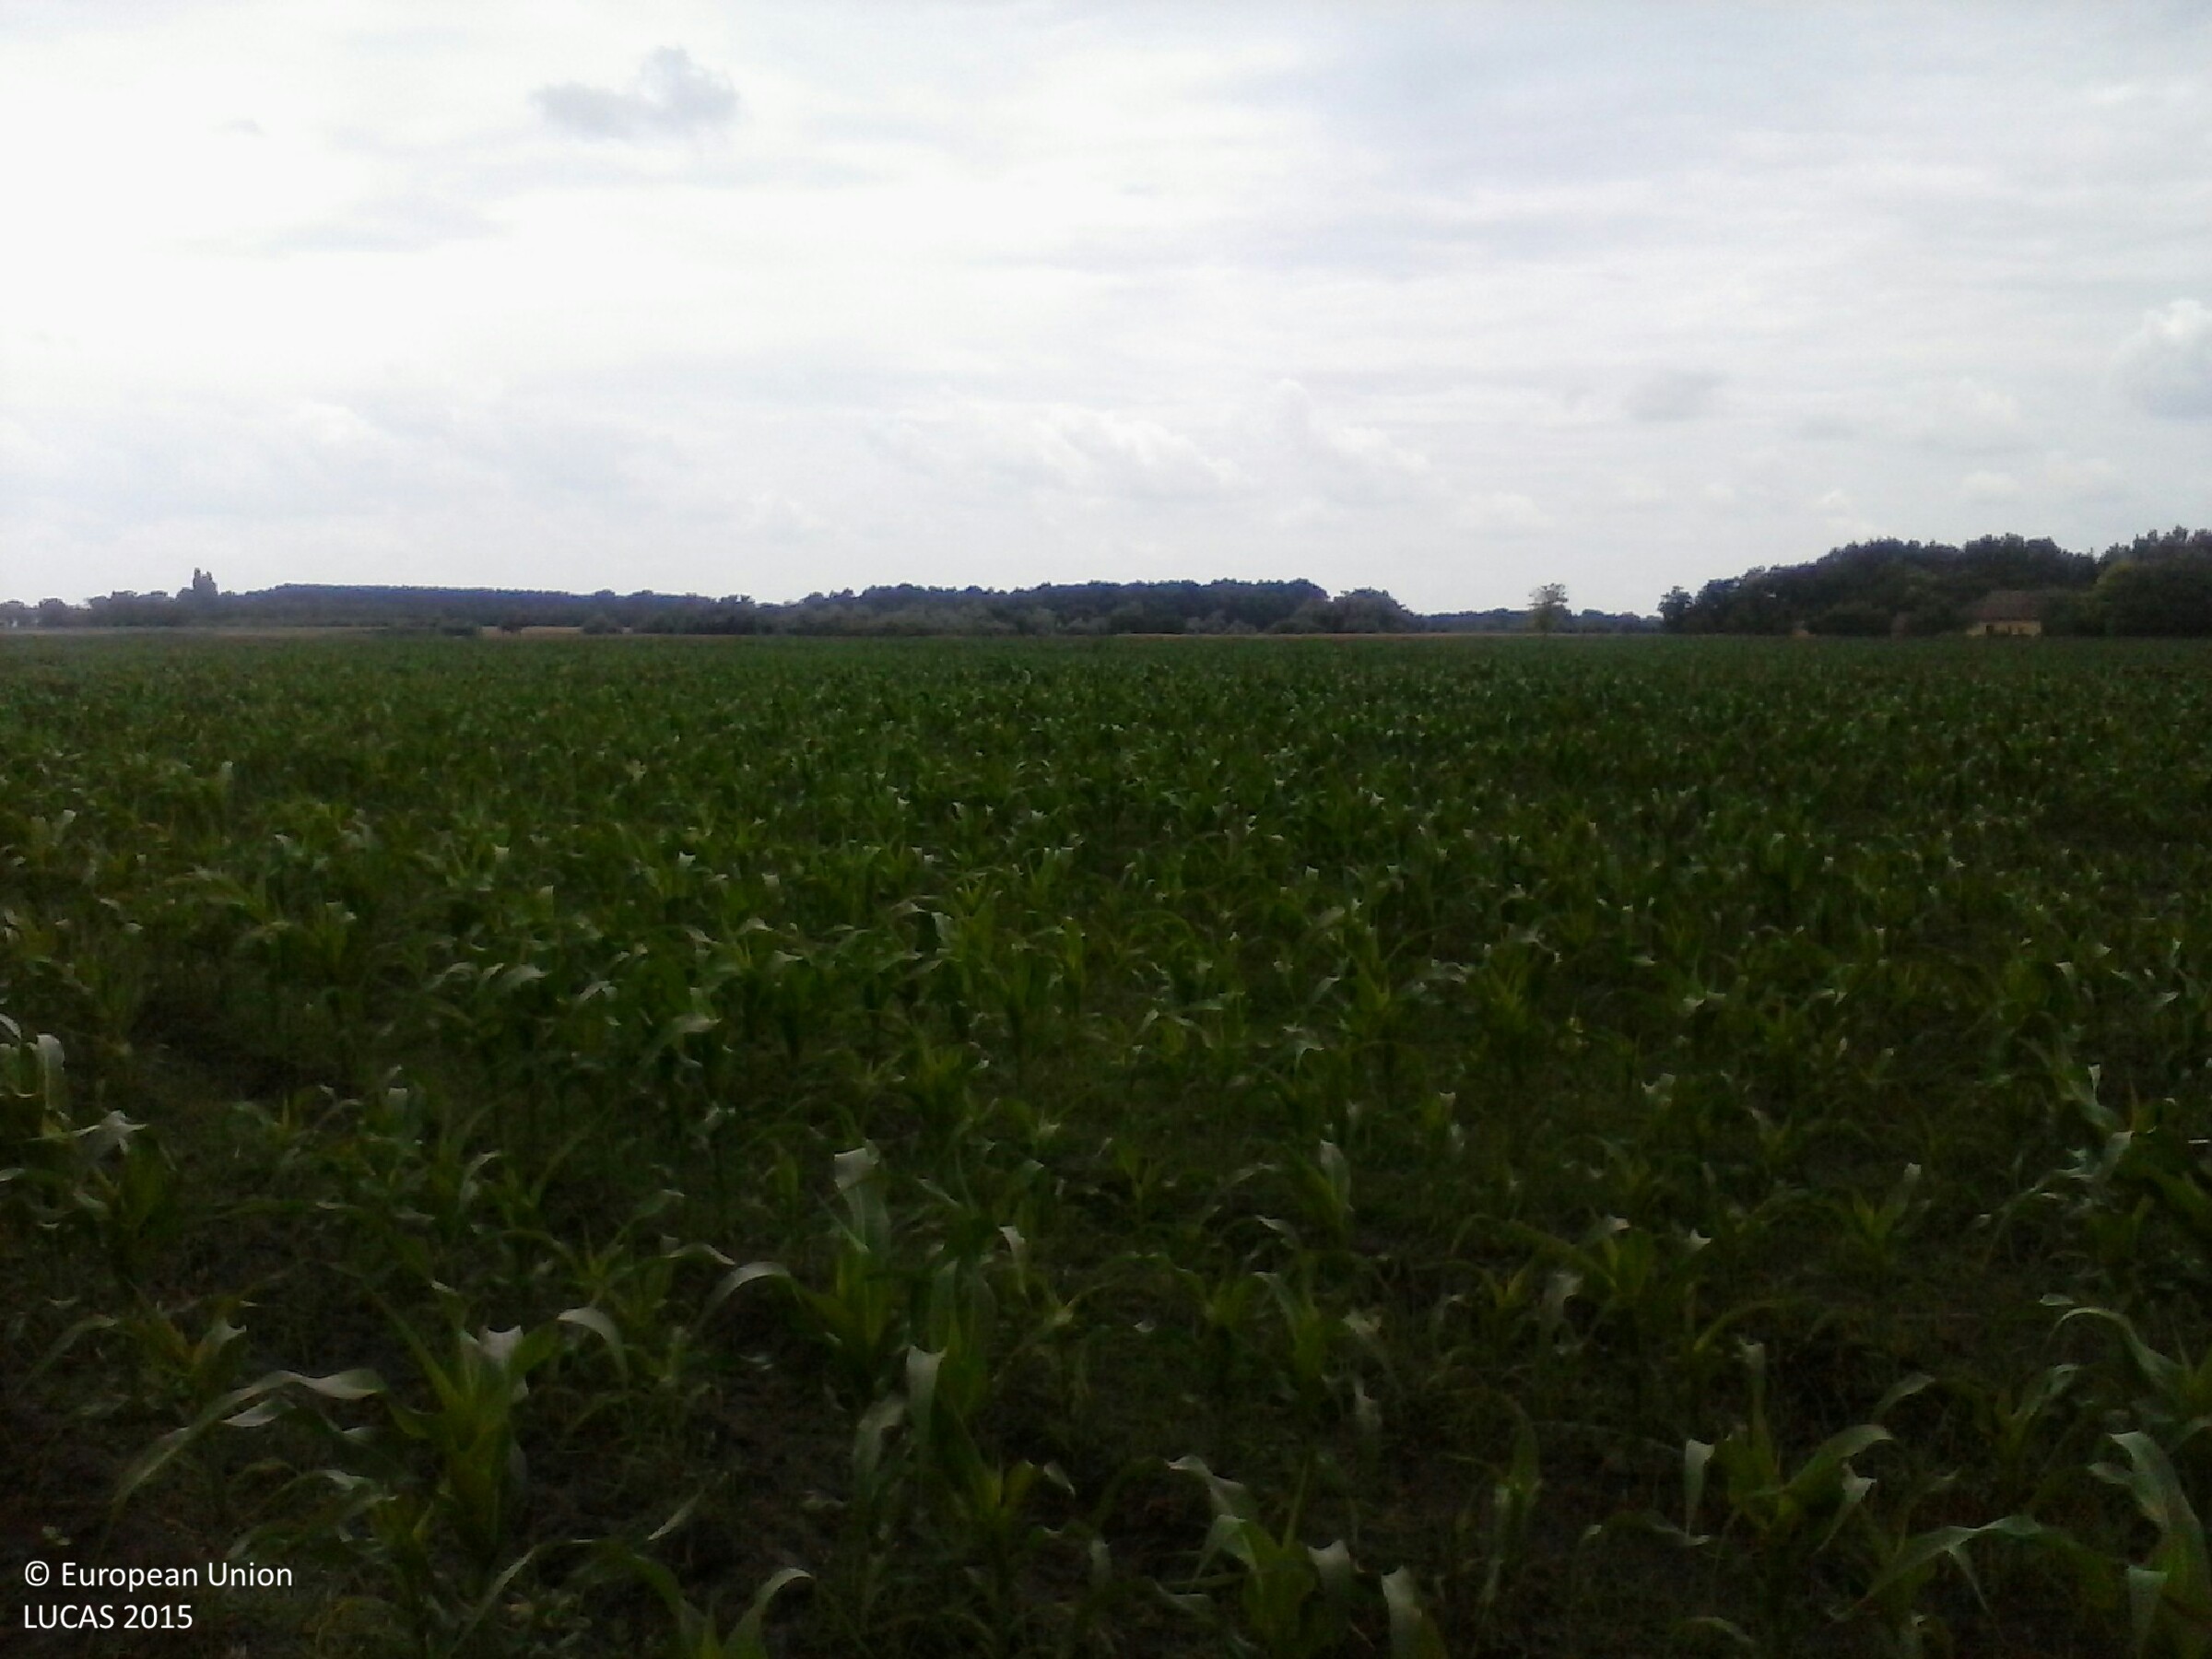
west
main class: Cropland
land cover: Maize
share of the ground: 50 - 75 %
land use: Agriculture (excluding fallow land and kitchen gardens)
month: June
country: HU
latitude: 46.4029
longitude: 20.0502
